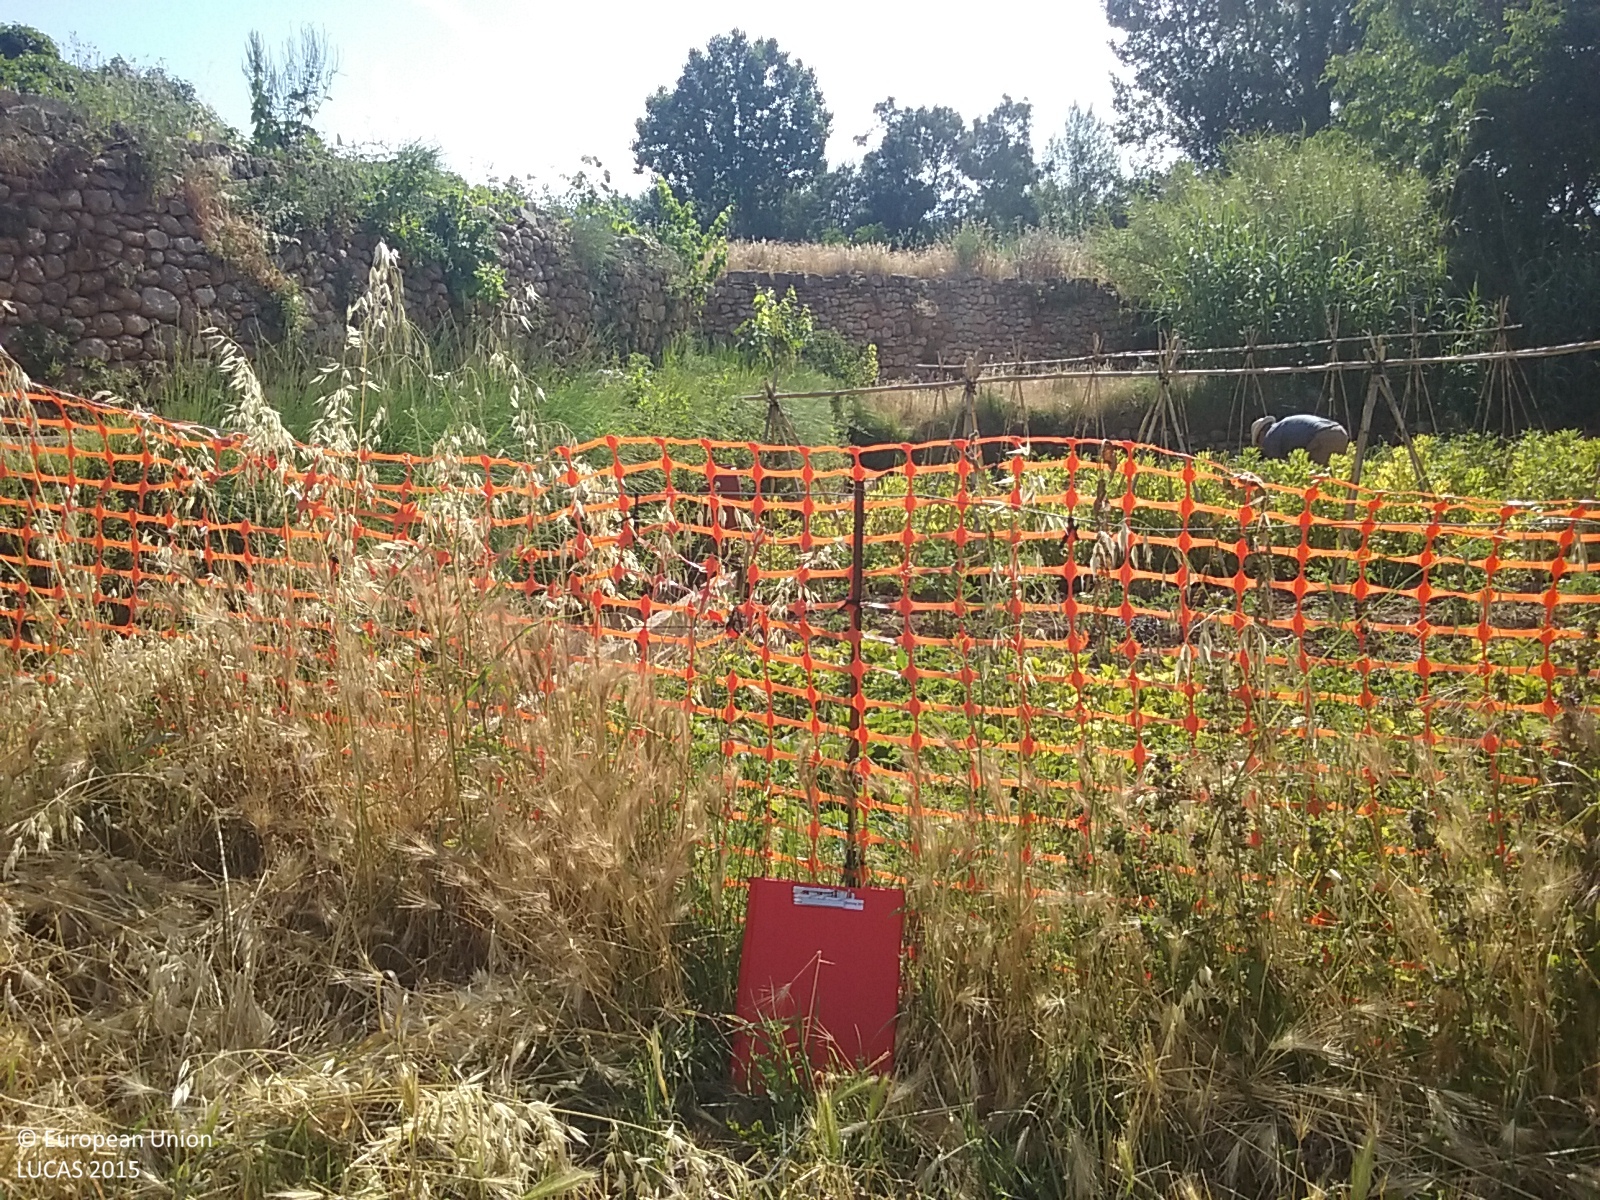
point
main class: Grassland
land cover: Spontaneously vegetated surfaces
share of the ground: > 75 %
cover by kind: herbaceous plants 100 %
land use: Abandoned areas
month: June
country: ES
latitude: 40.8637
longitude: 0.1564
